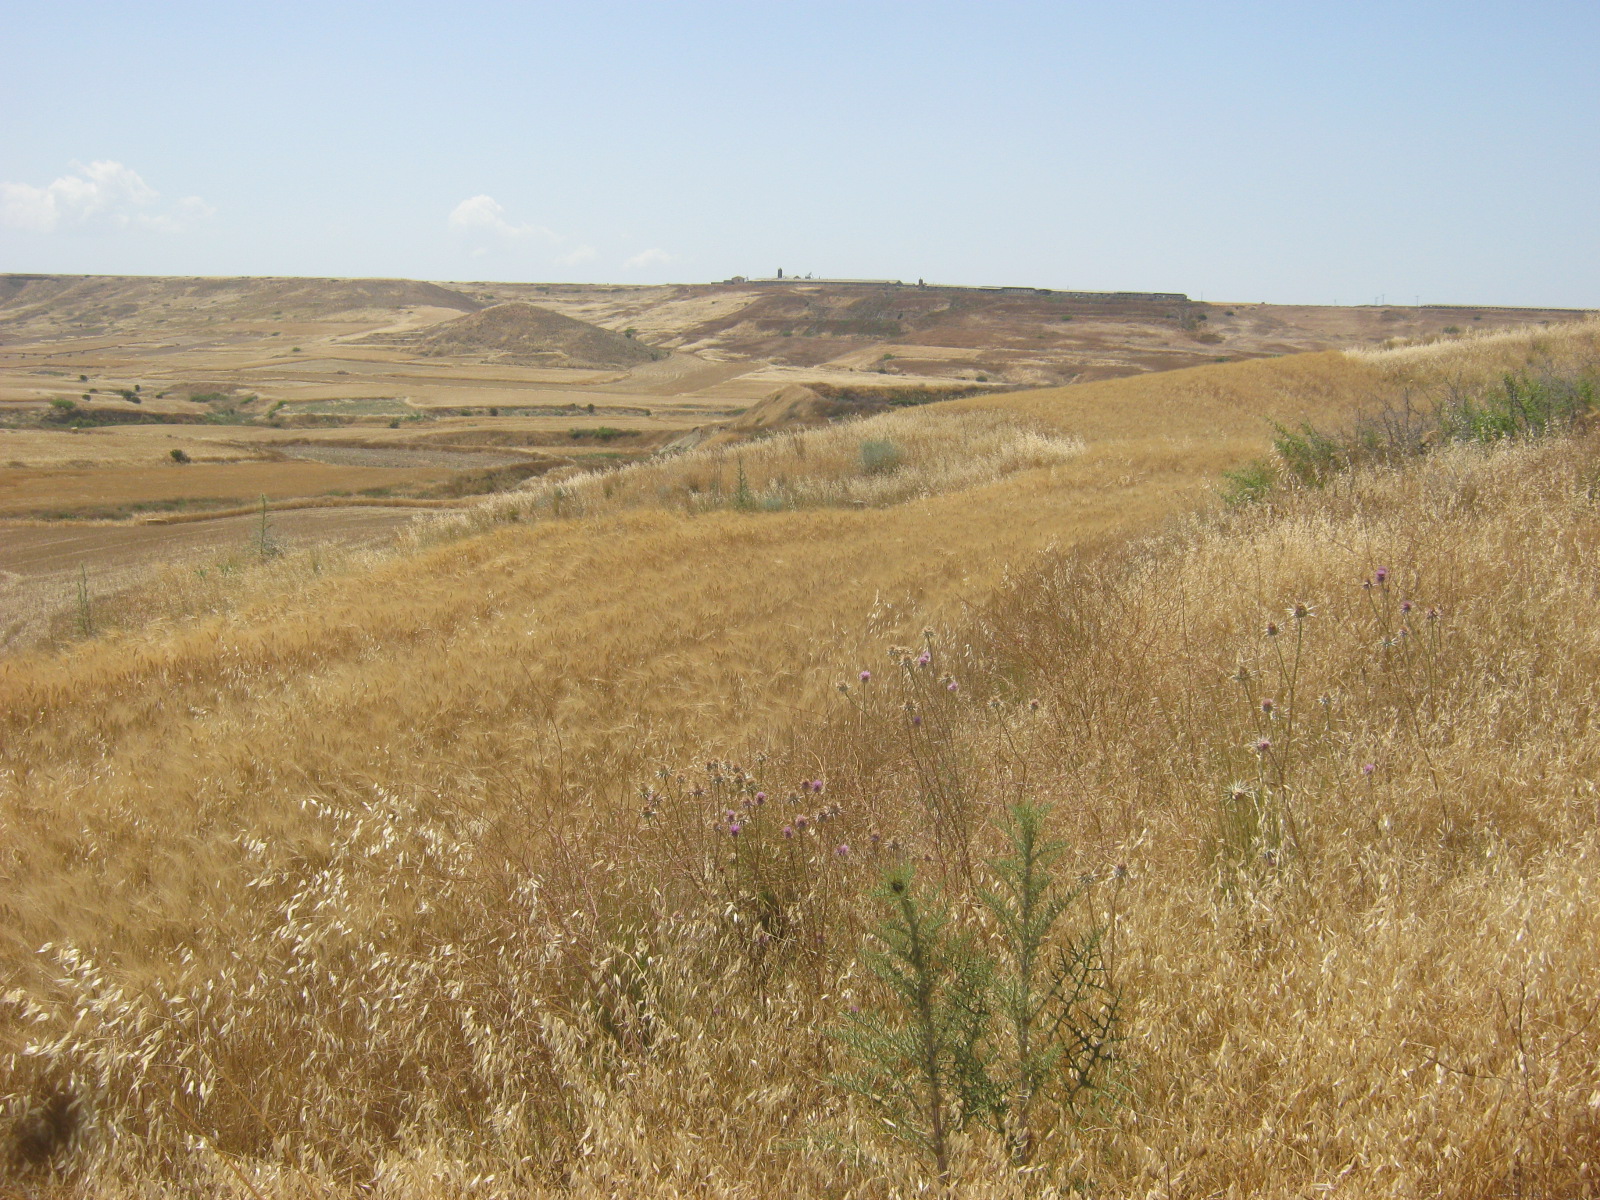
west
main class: Grassland
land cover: Spontaneously vegetated surfaces
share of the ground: 50 - 75 %
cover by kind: herbaceous plants 100 %
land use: Semi-natural and natural areas not in use
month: May
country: CY
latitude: 35.1007
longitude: 33.1207
